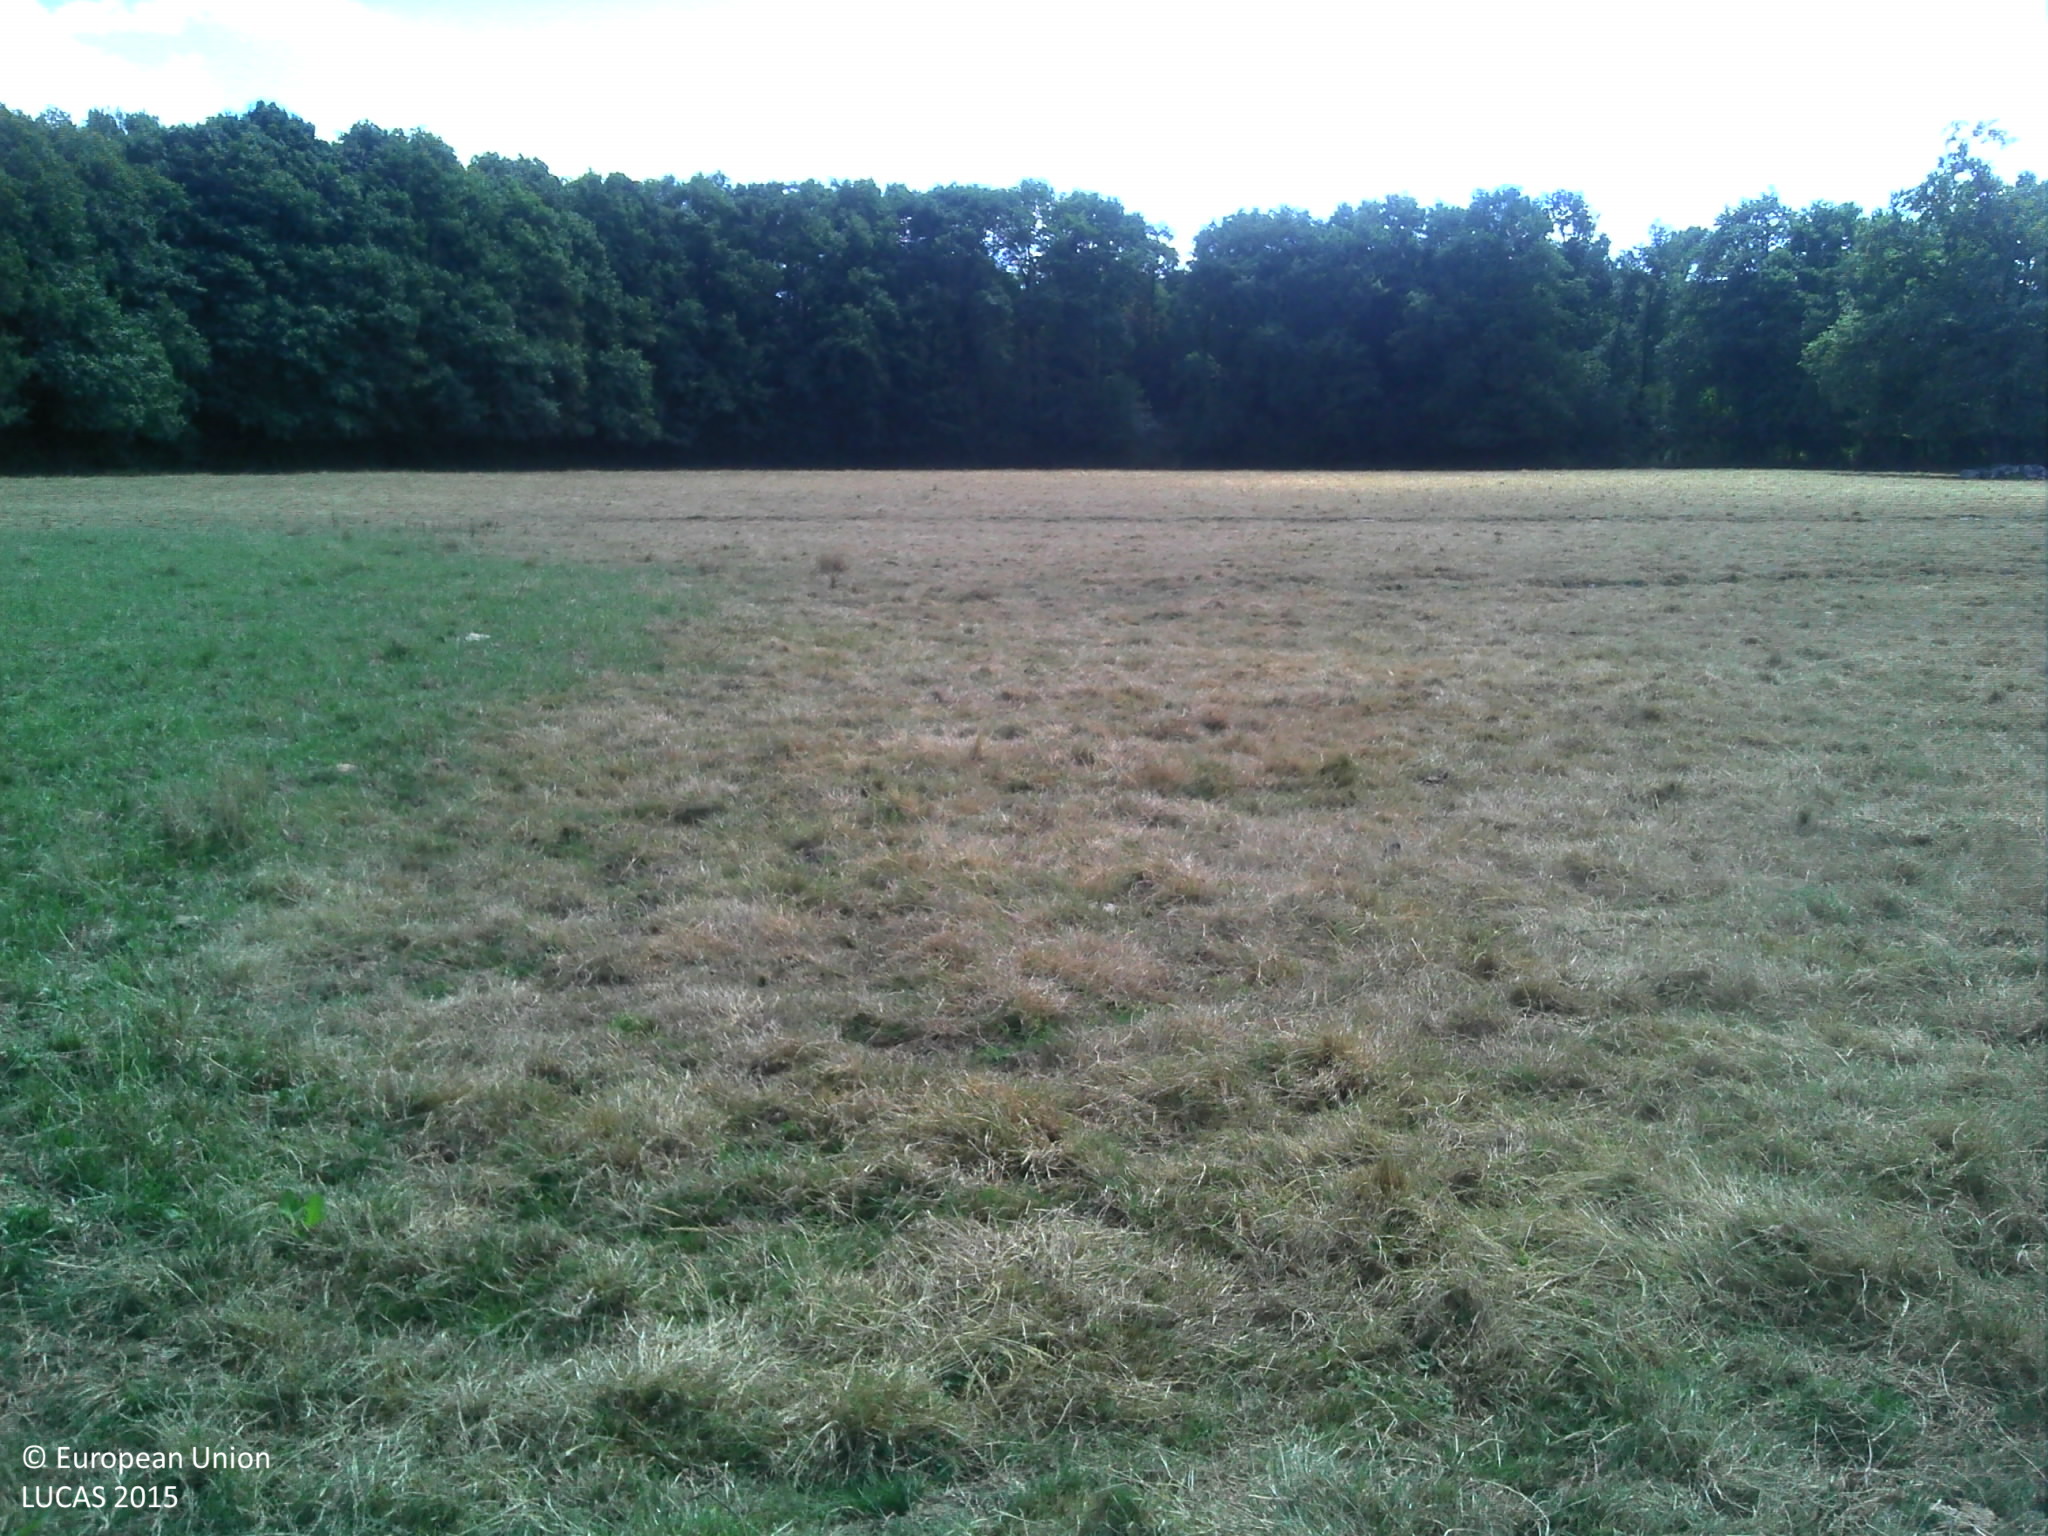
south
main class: Grassland
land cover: Grassland without tree/shrub cover
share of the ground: > 75 %
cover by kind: herbaceous plants 100 %
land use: Agriculture (excluding fallow land and kitchen gardens)
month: August
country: FR
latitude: 46.6905
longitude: -1.3476
